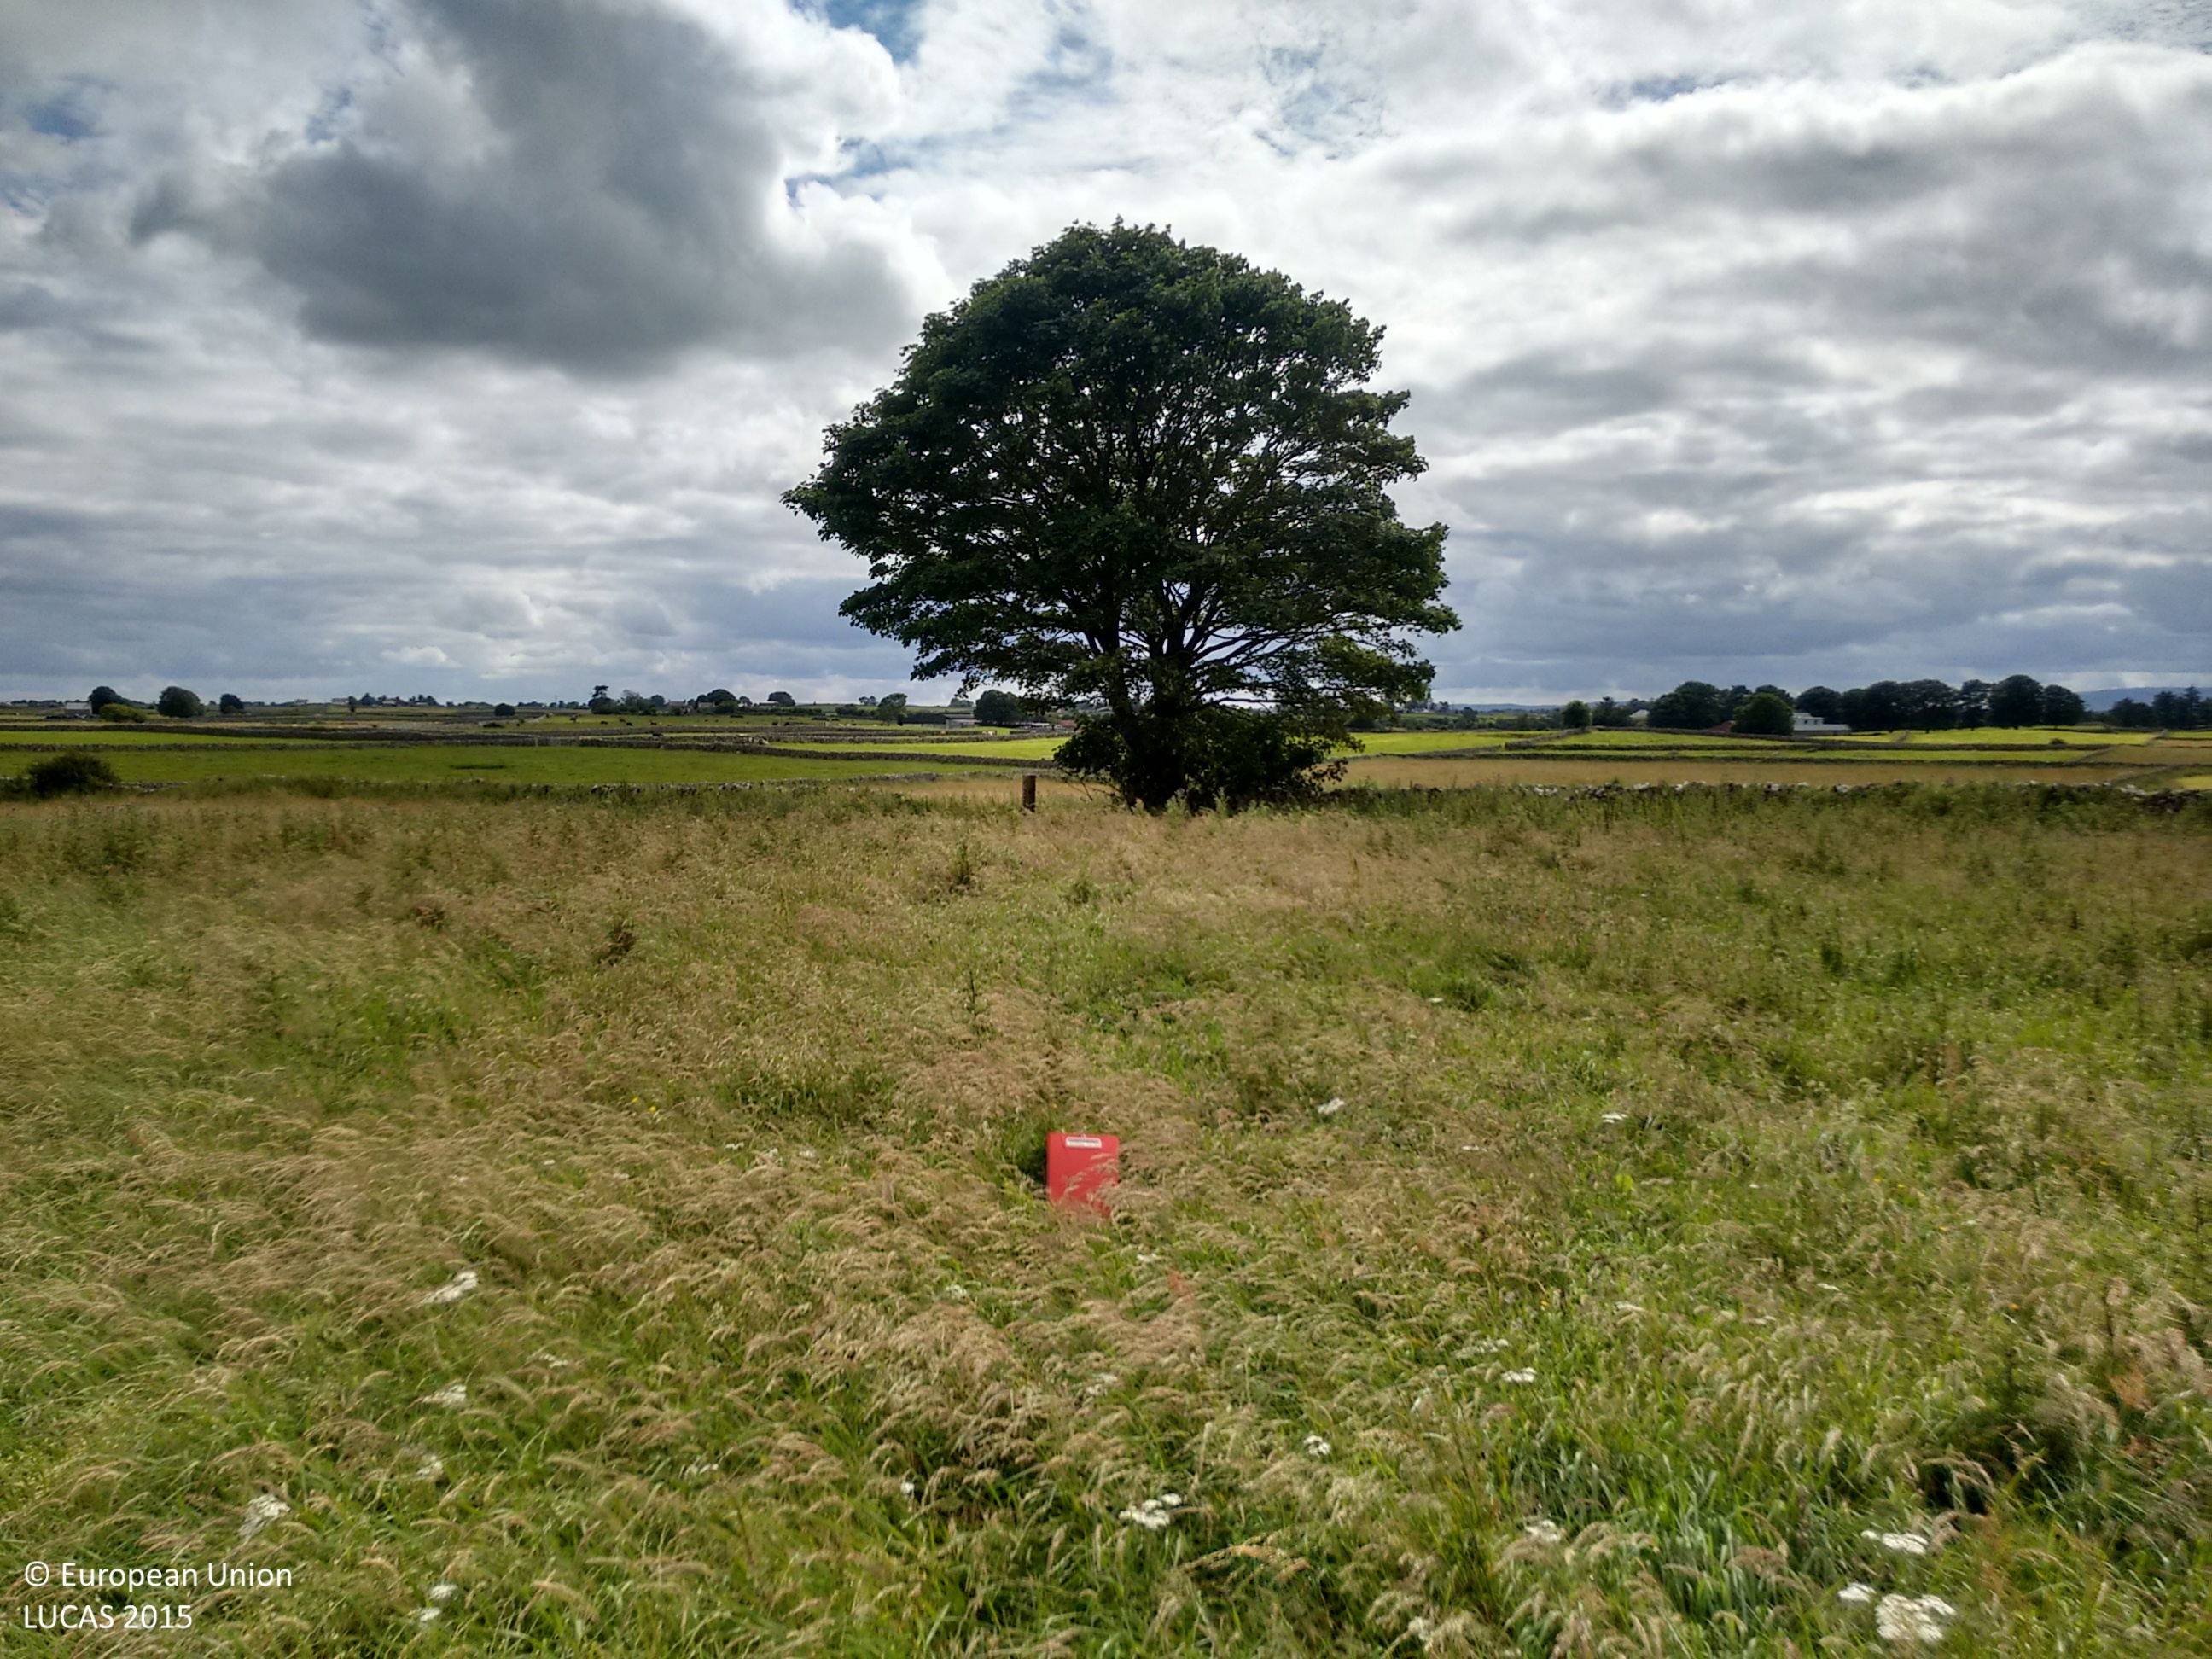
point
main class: Grassland
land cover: Grassland without tree/shrub cover
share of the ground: > 75 %
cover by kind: herbaceous plants 100 %
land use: Agriculture (excluding fallow land and kitchen gardens)
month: July
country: IE
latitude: 53.6146
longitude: -9.1277
